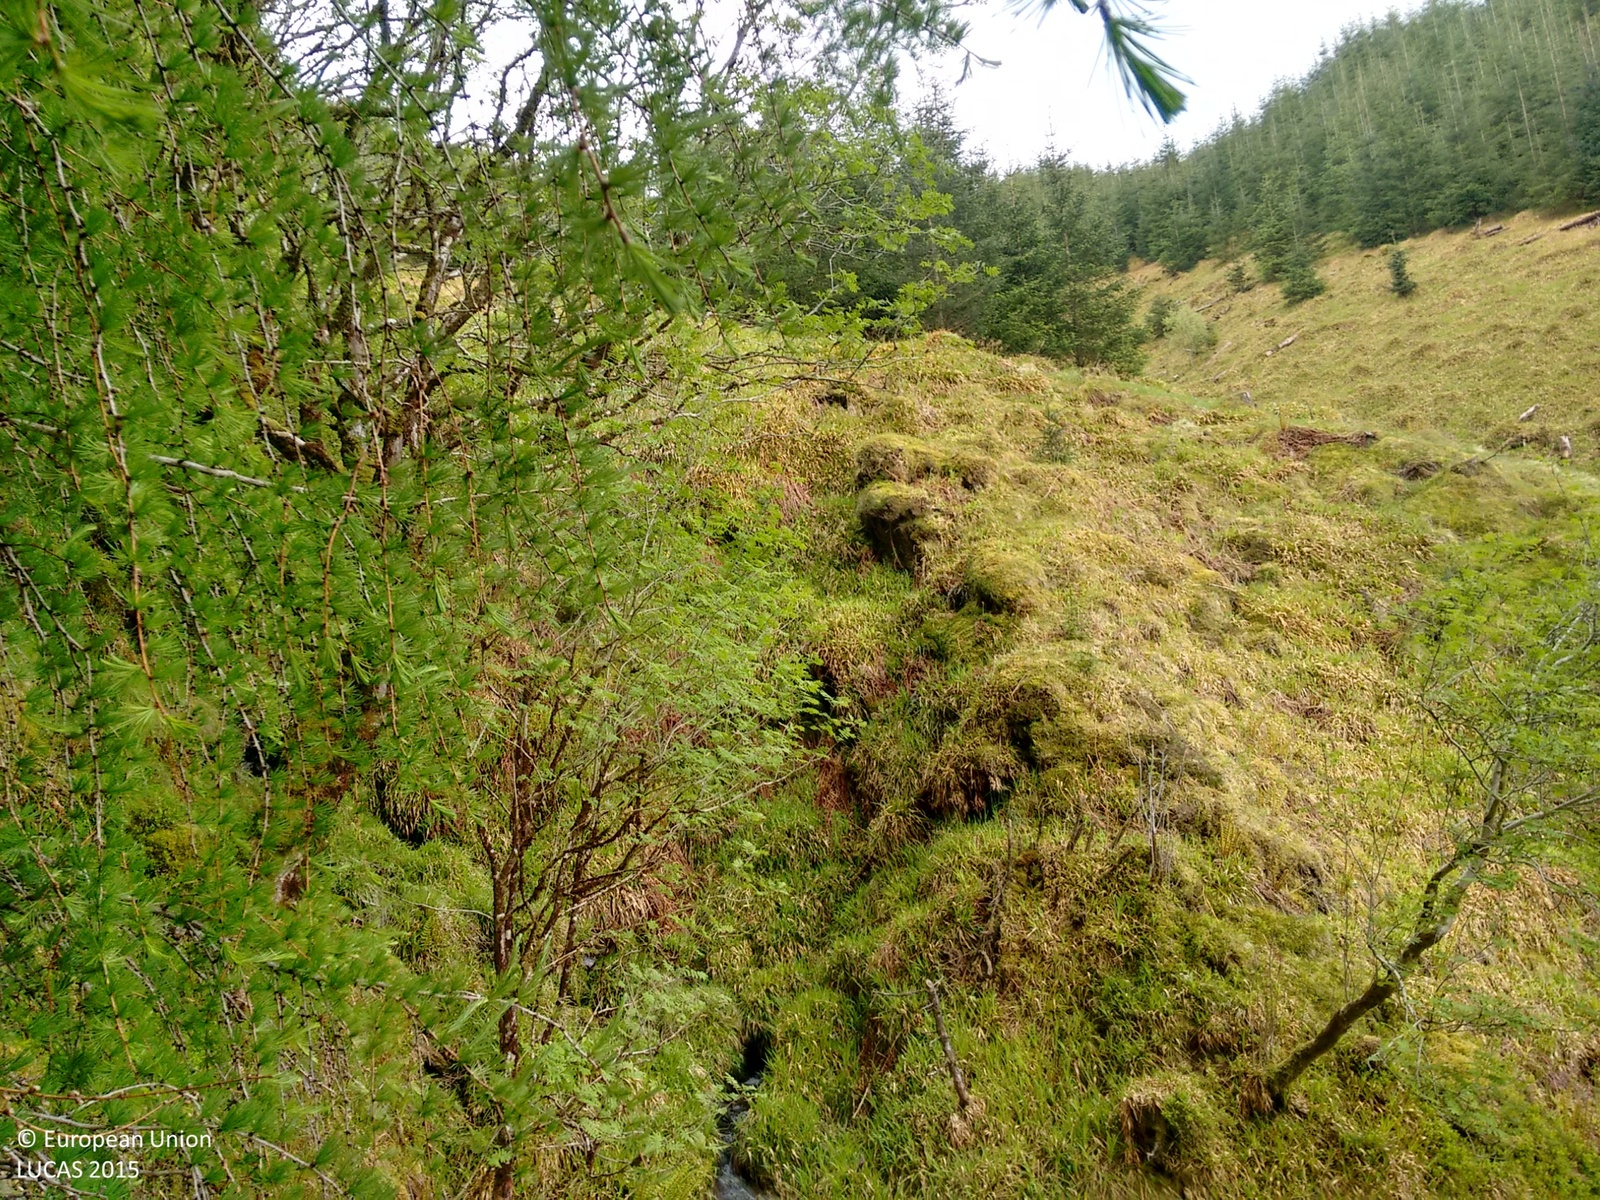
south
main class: Grassland
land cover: Grassland with sparse tree/shrub cover
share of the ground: > 75 %
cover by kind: herbaceous plants 95 %, broadleaved forest trees 5 %
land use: Forestry
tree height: > 5 m
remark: Fire break
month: June
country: GB
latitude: 56.2621
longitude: -5.3744
